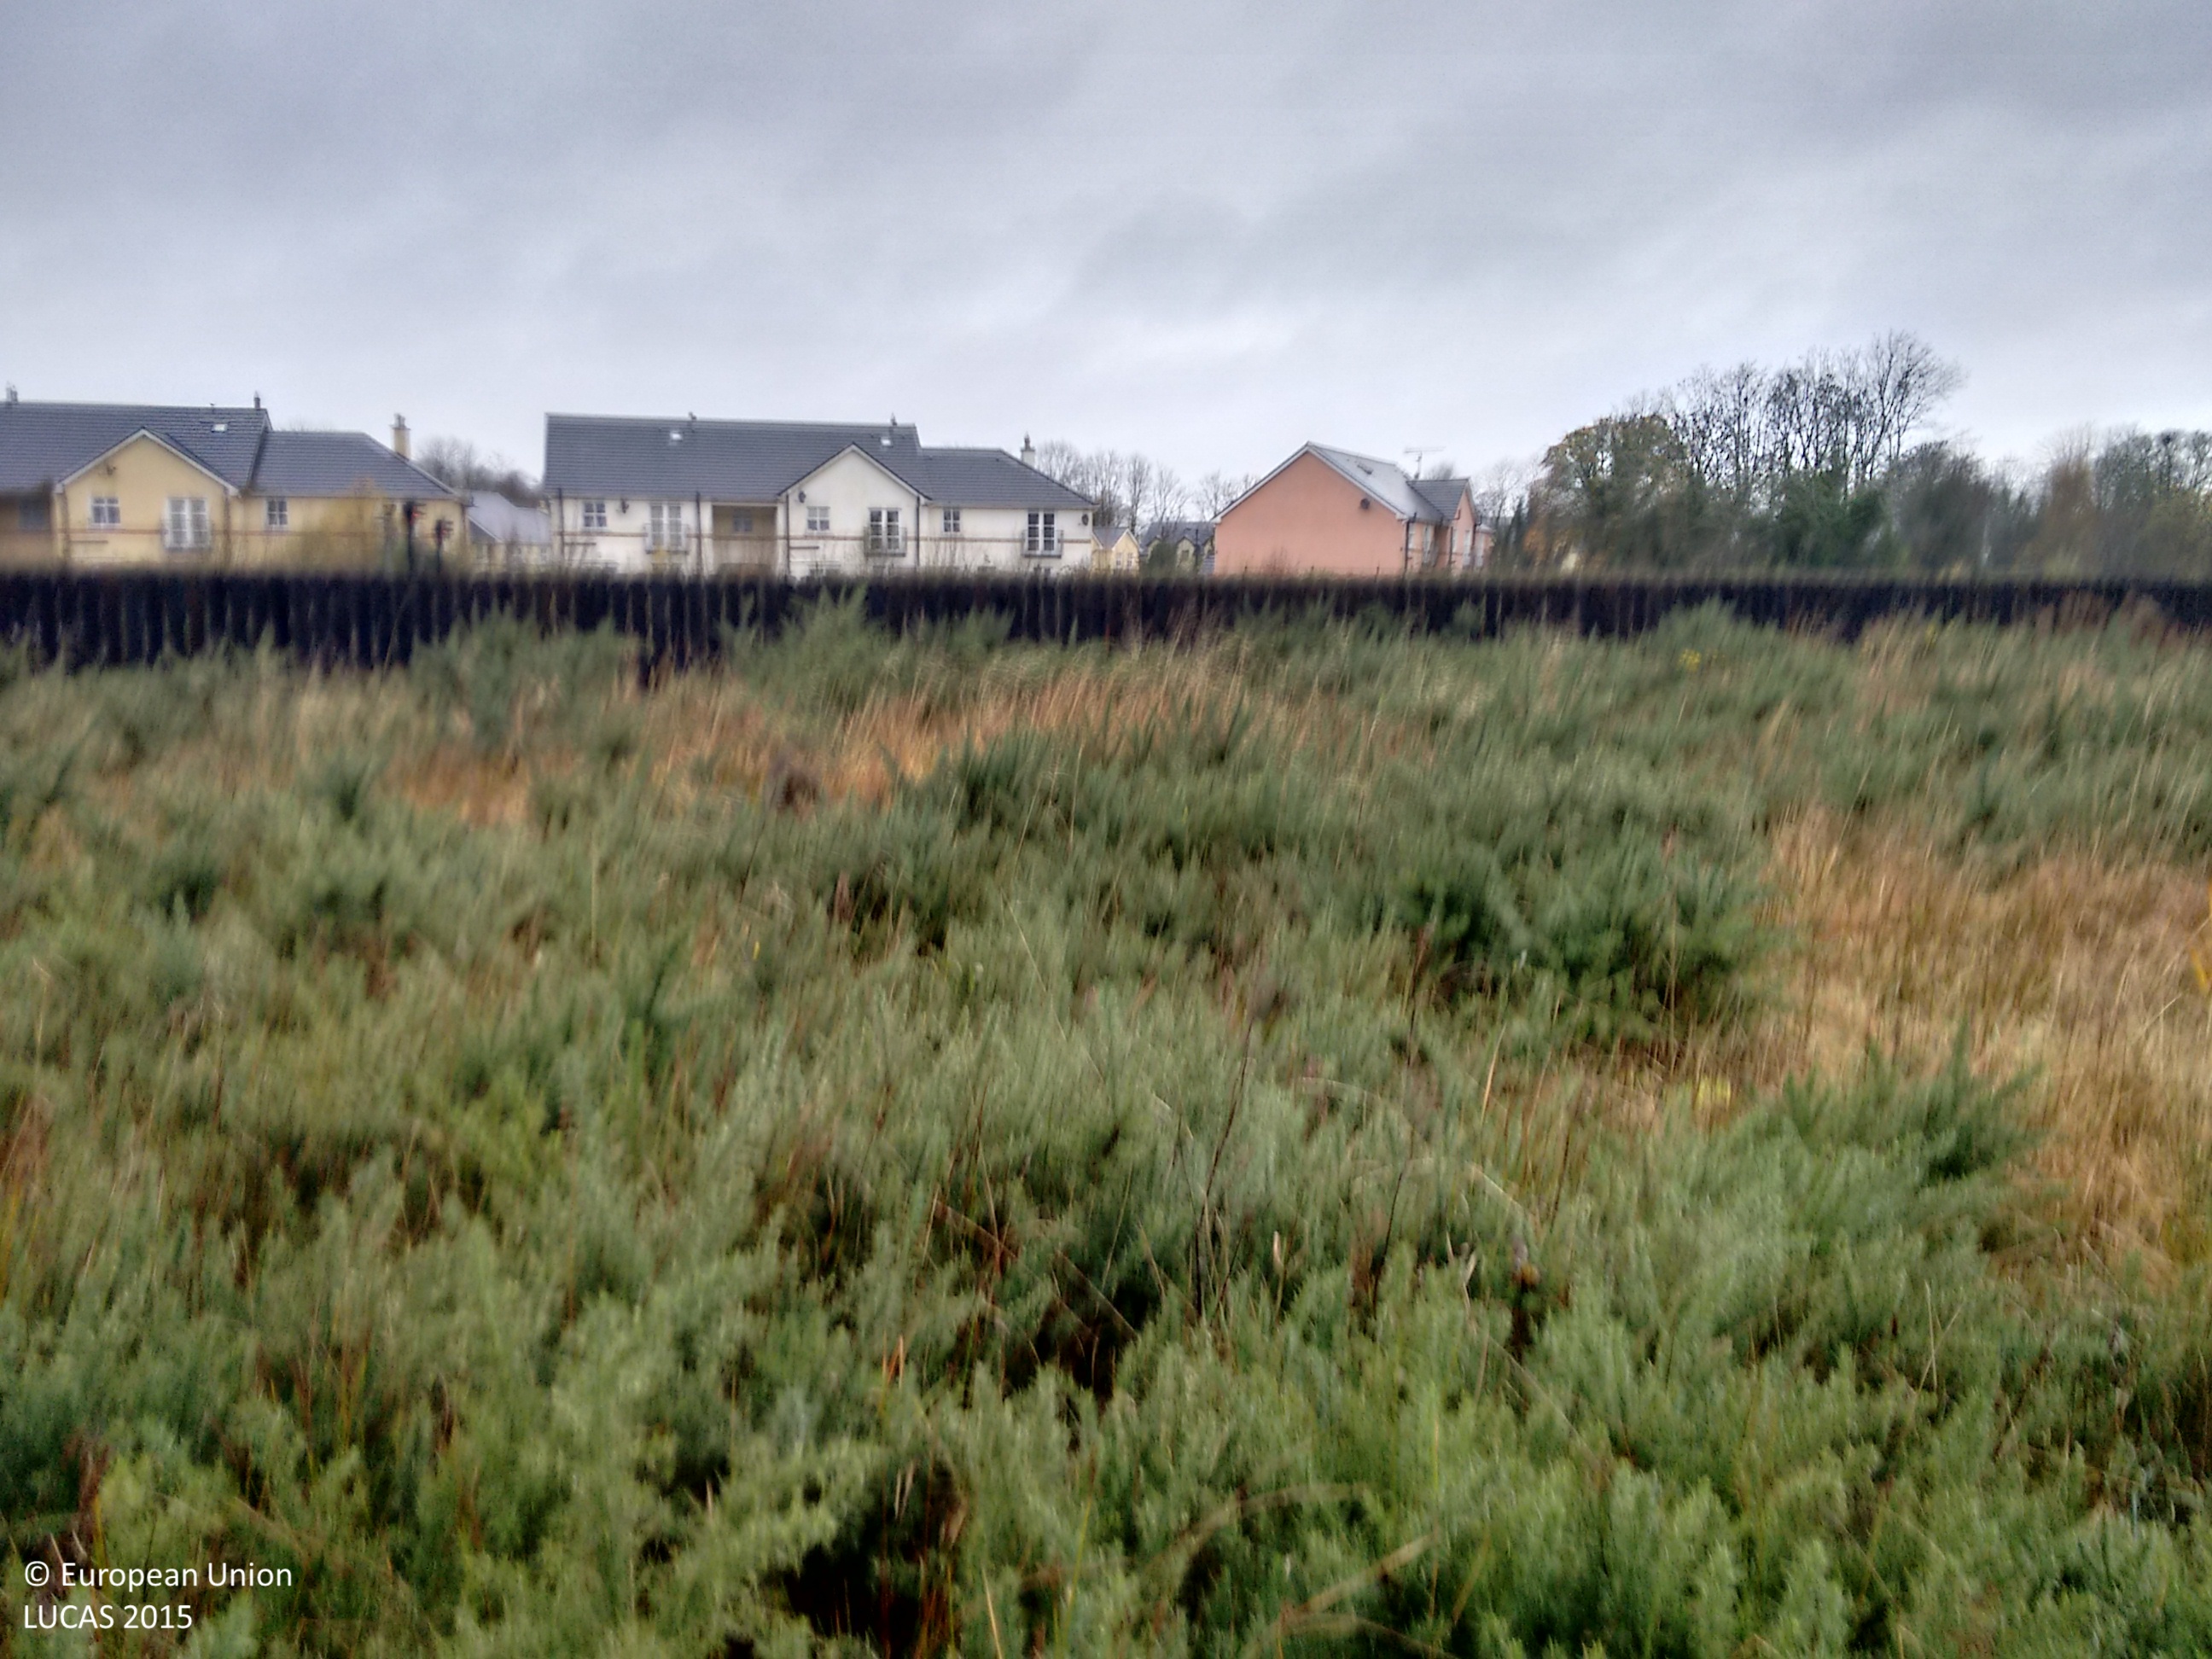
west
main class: Grassland
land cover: Spontaneously vegetated surfaces
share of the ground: > 75 %
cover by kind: herbaceous plants 95 %, shrubs 5 %
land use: Abandoned areas
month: November
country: IE
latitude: 53.8579
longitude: -7.9144
